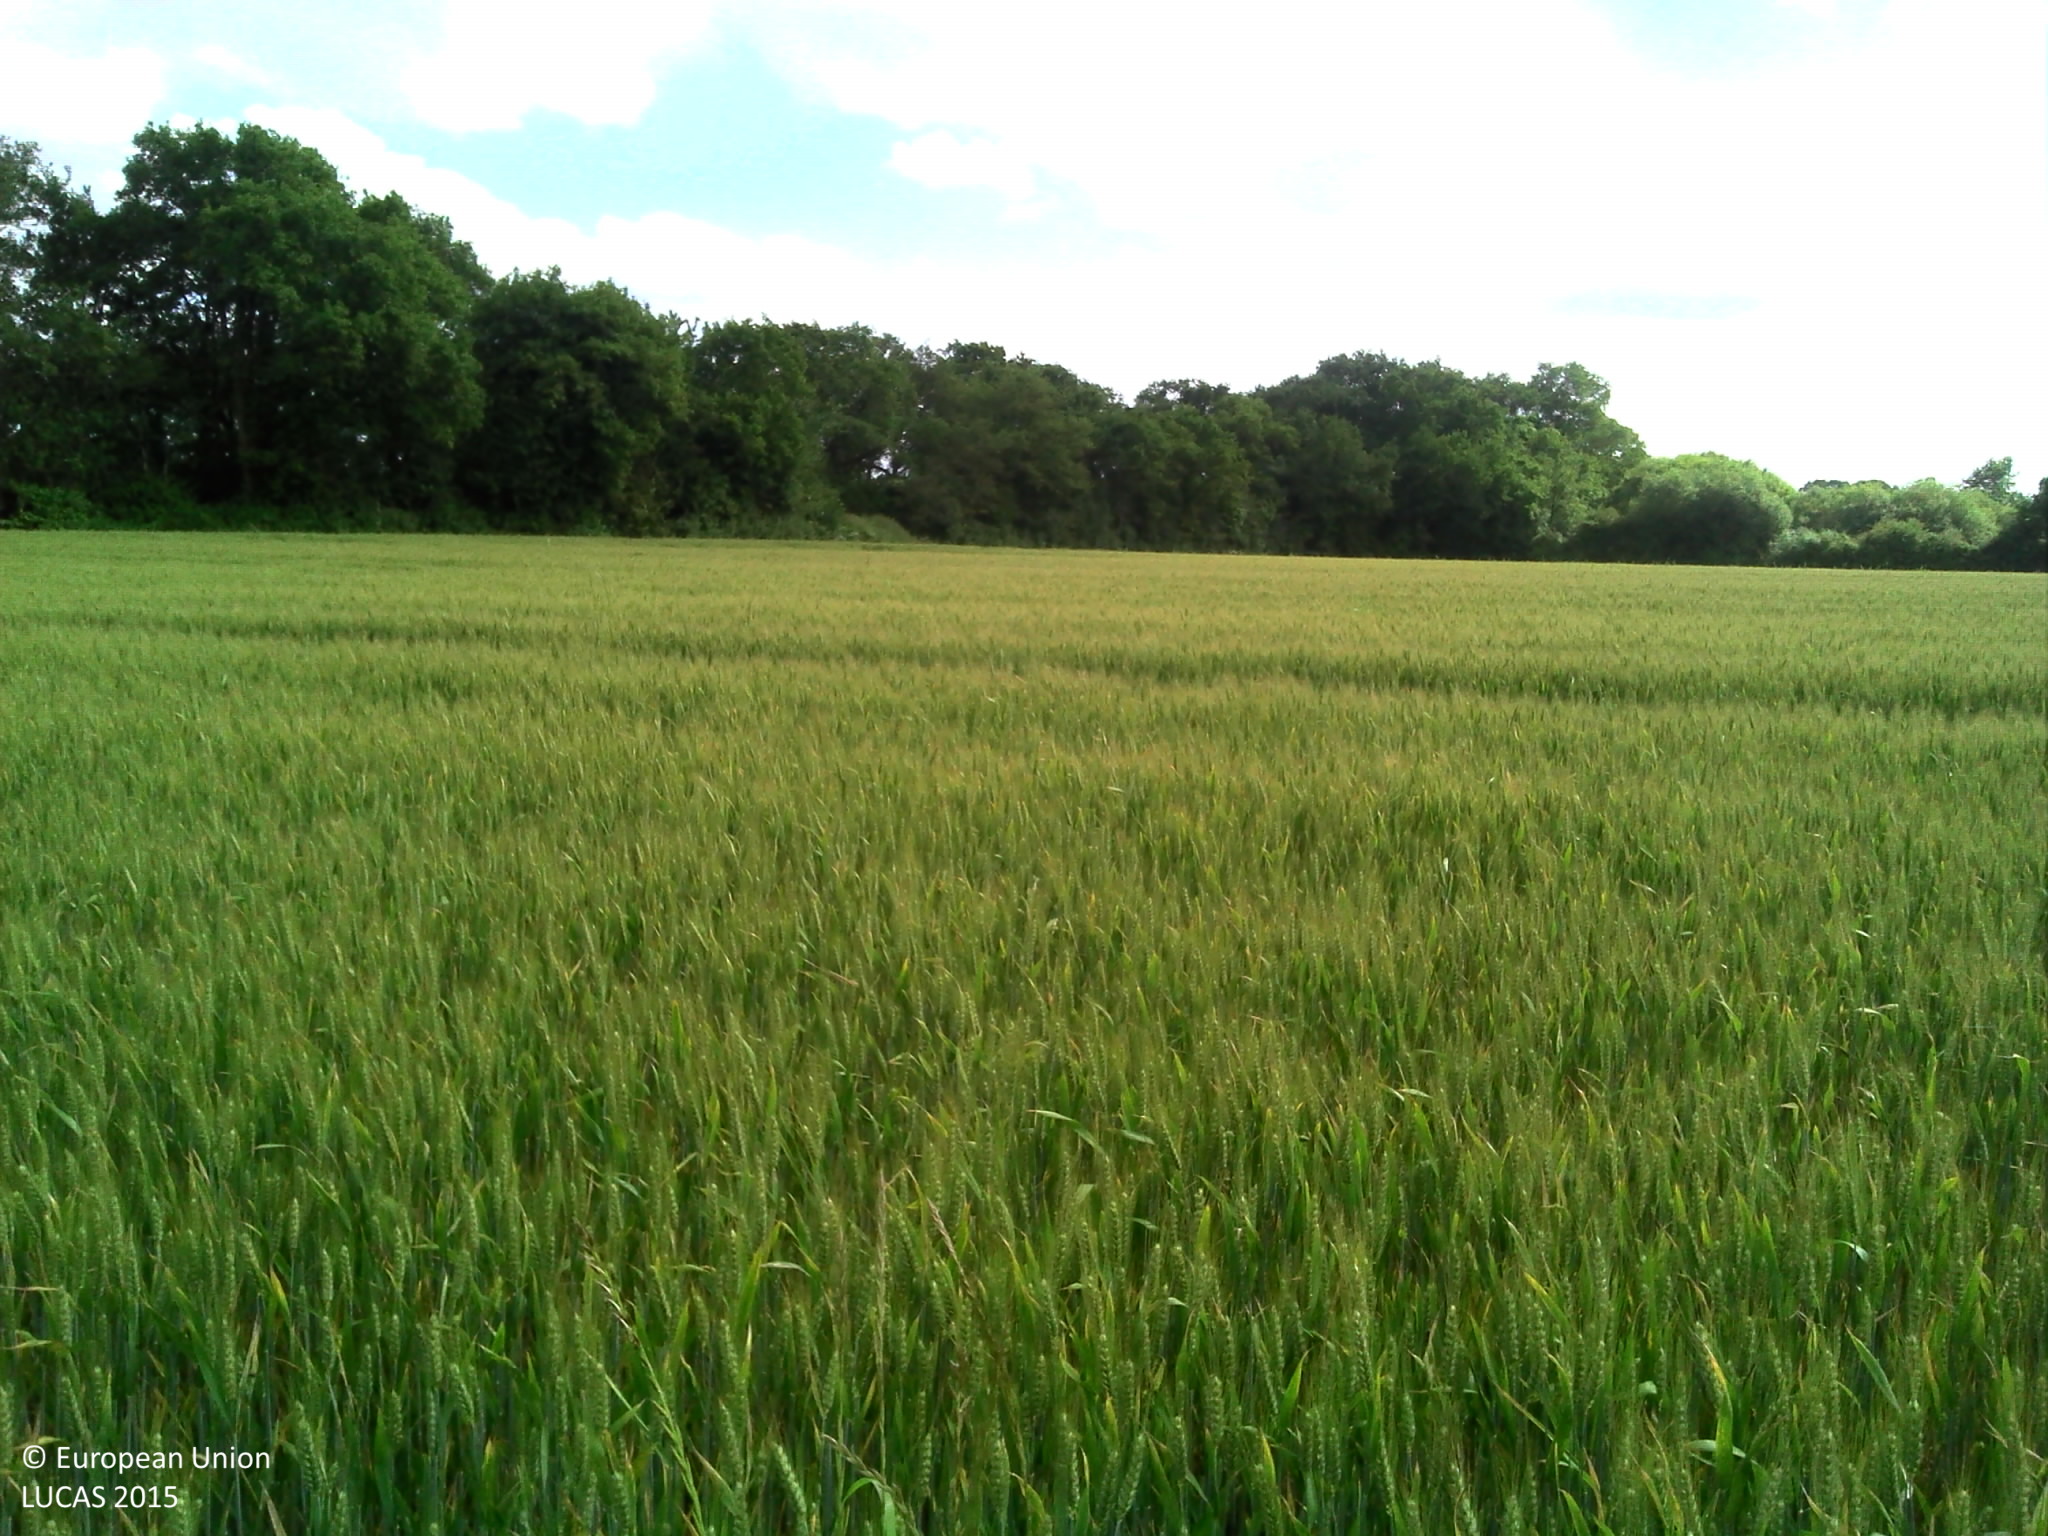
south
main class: Cropland
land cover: Common wheat
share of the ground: > 75 %
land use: Agriculture (excluding fallow land and kitchen gardens)
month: June
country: FR
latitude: 46.8737
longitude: -1.8393
